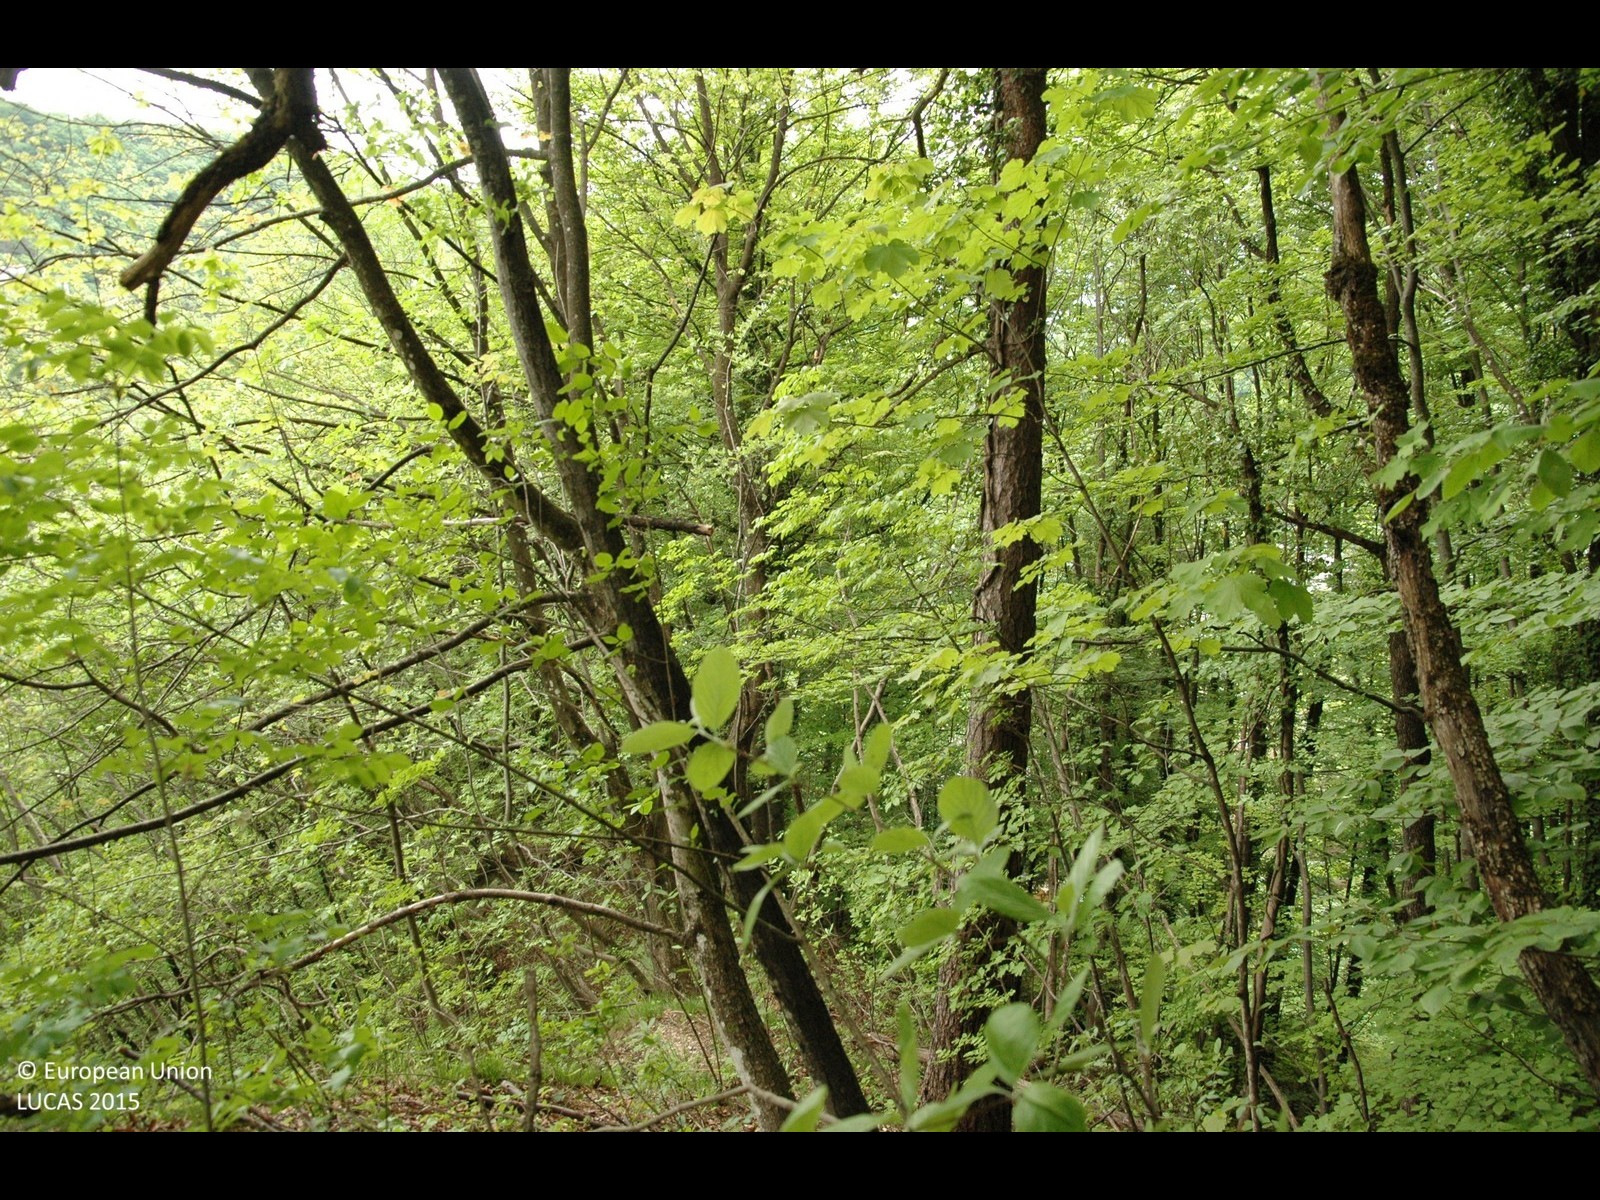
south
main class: Woodland
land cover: Broadleaved woodland
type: beech forest
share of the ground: > 75 %
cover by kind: broadleaved forest trees 95 %, consolidated bare surface 5 %
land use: Forestry
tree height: > 5 m
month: May
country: HR
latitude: 45.8021
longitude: 15.6972
